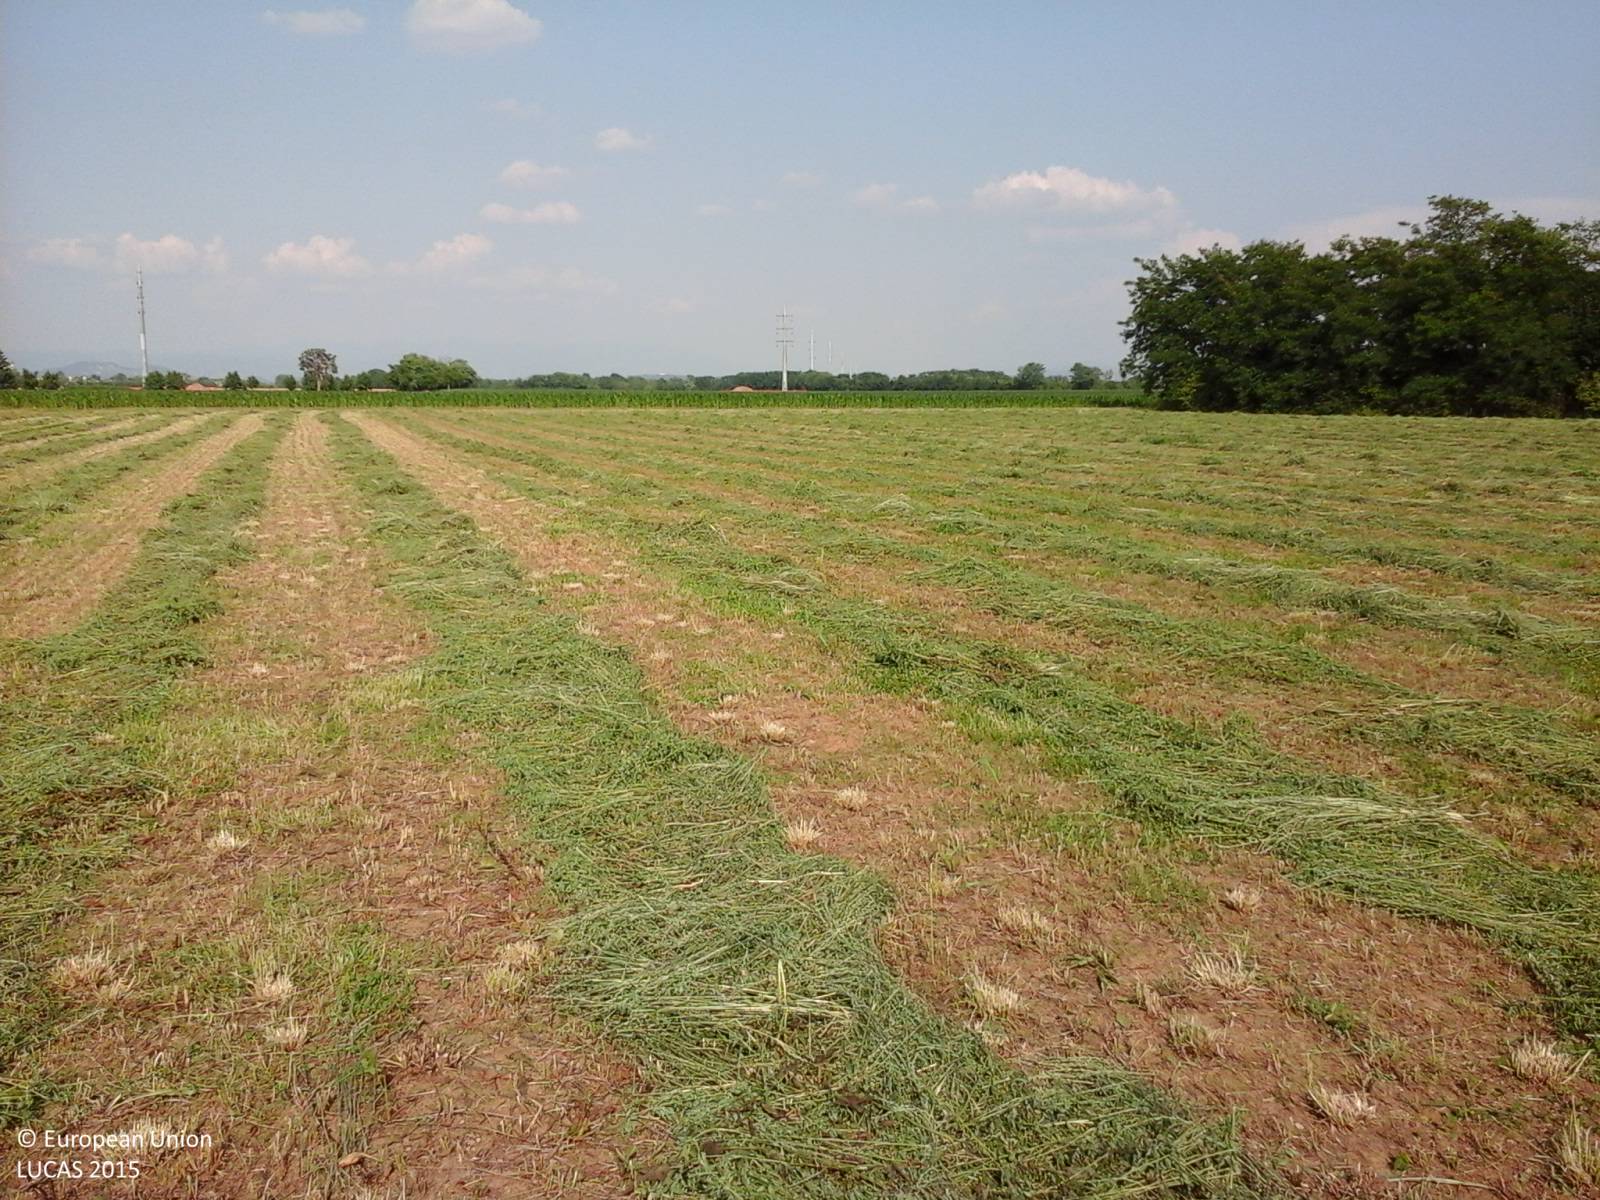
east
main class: Cropland
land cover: Lucerne
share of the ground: > 75 %
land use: Agriculture (excluding fallow land and kitchen gardens)
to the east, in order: Lucerne; Tracks; Maize; Tracks; Soya
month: June
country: IT
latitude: 45.9214
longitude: 13.3100
